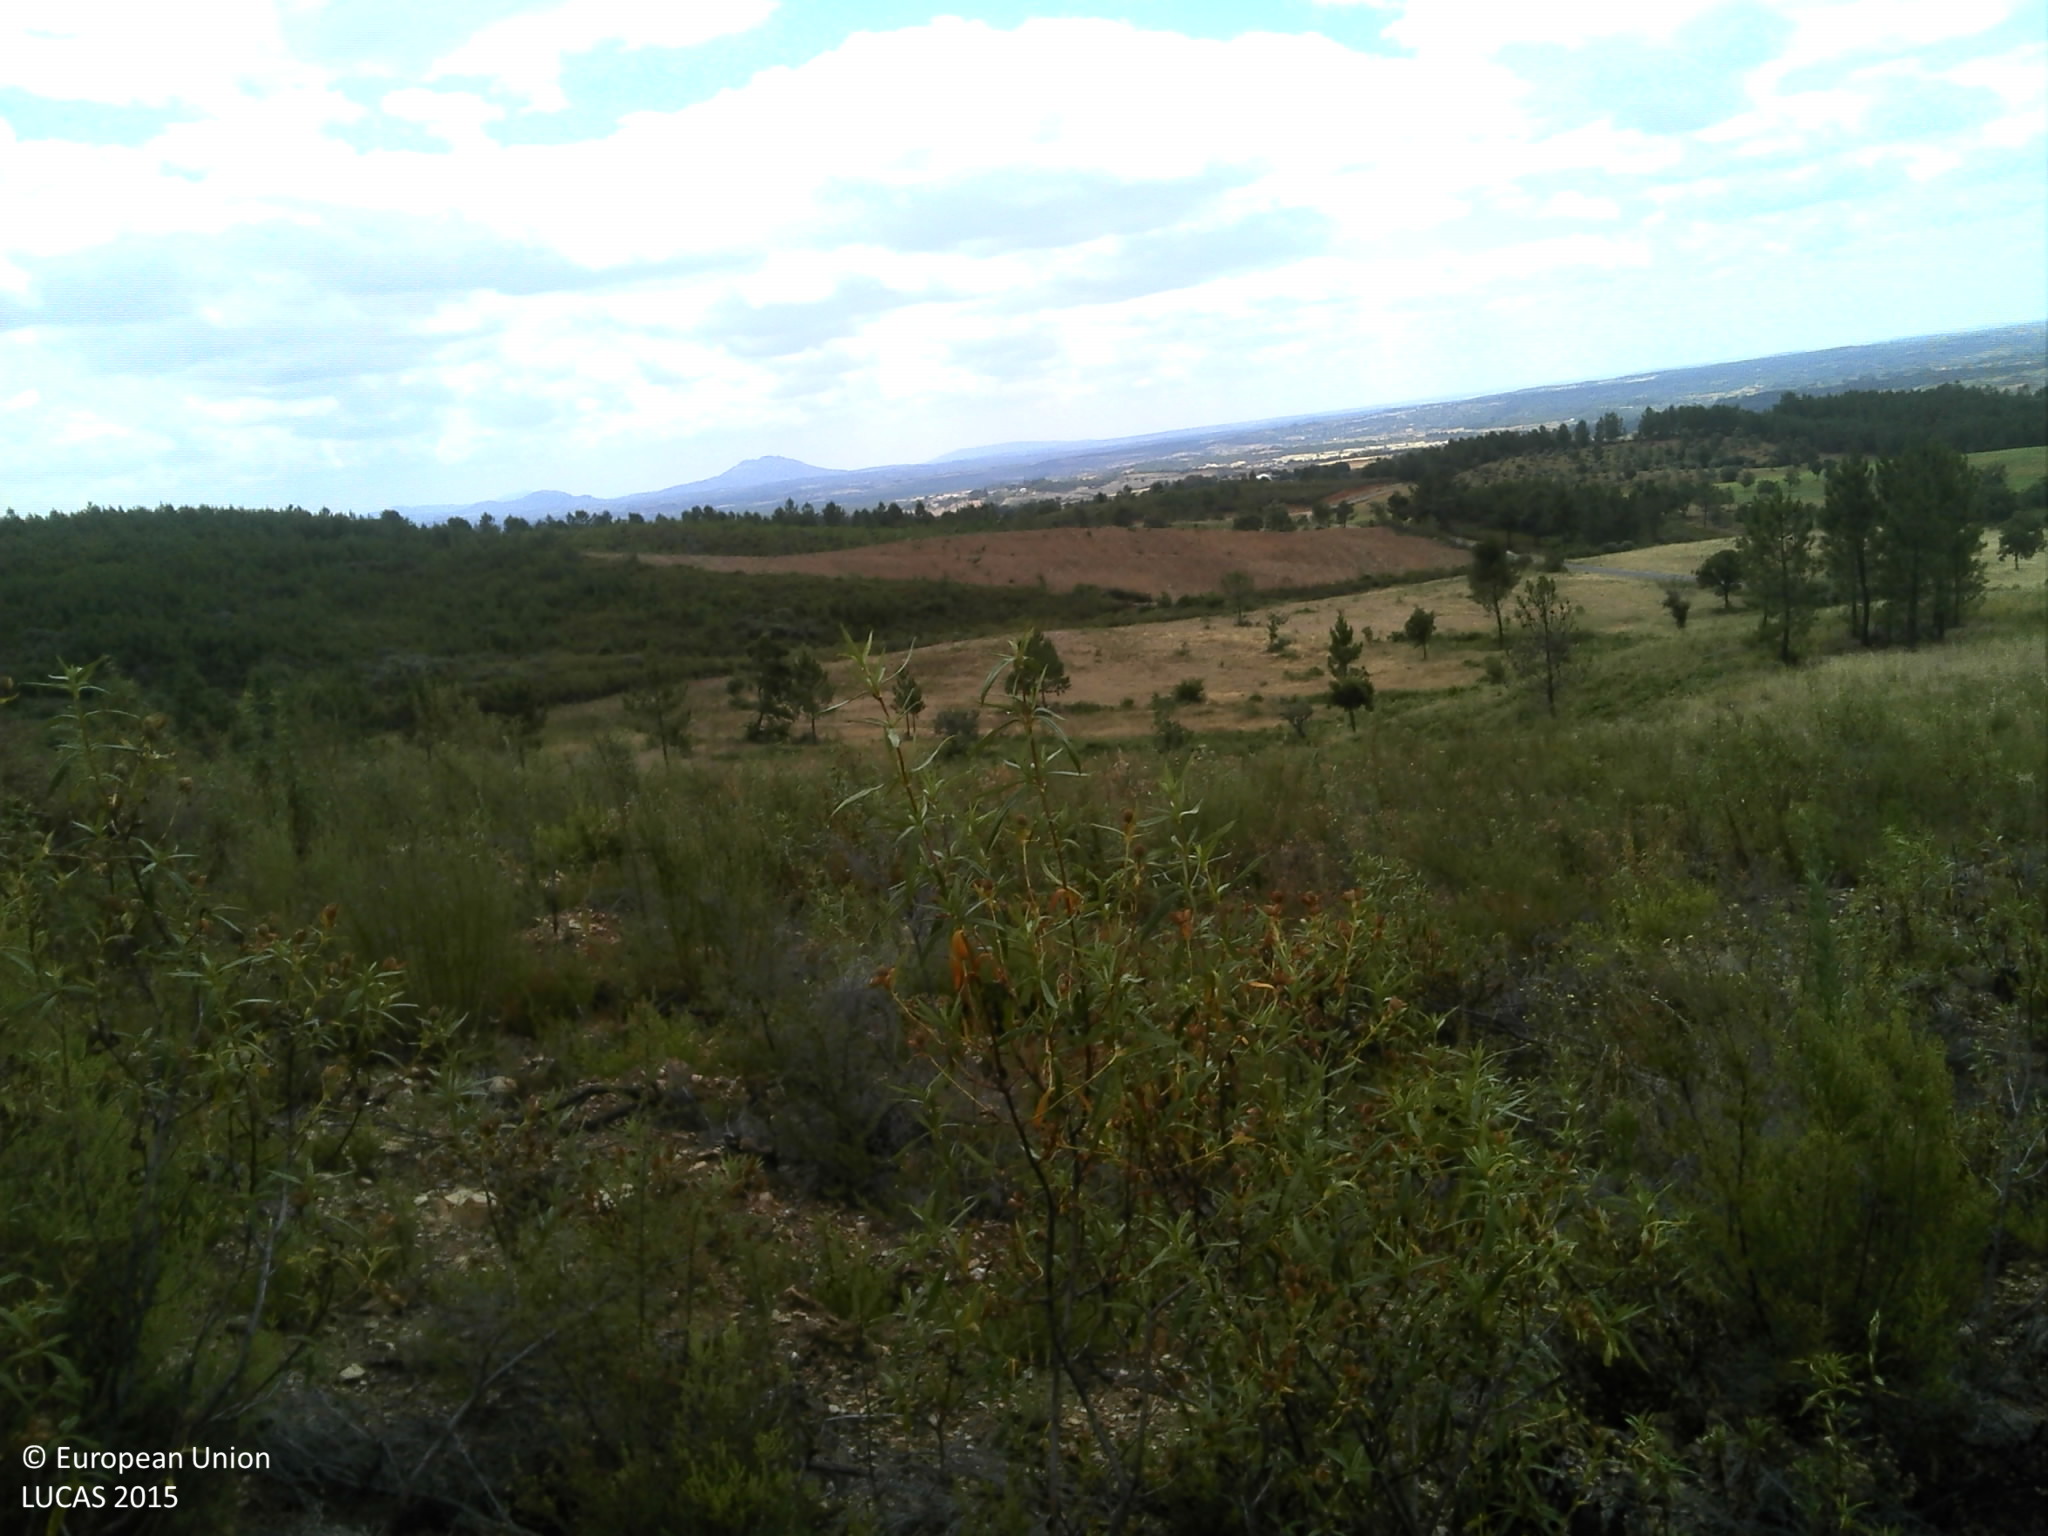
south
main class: Woodland
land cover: Pine dominated coniferous woodland
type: coniferous forest of the mediterranean region
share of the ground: 10 - 25 %
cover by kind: shrubs 55 %, coniferous forest trees 25 %, unconsolidated bare surface 20 %
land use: Forestry
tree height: > 5 m
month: June
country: PT
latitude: 40.1266
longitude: -7.3633
